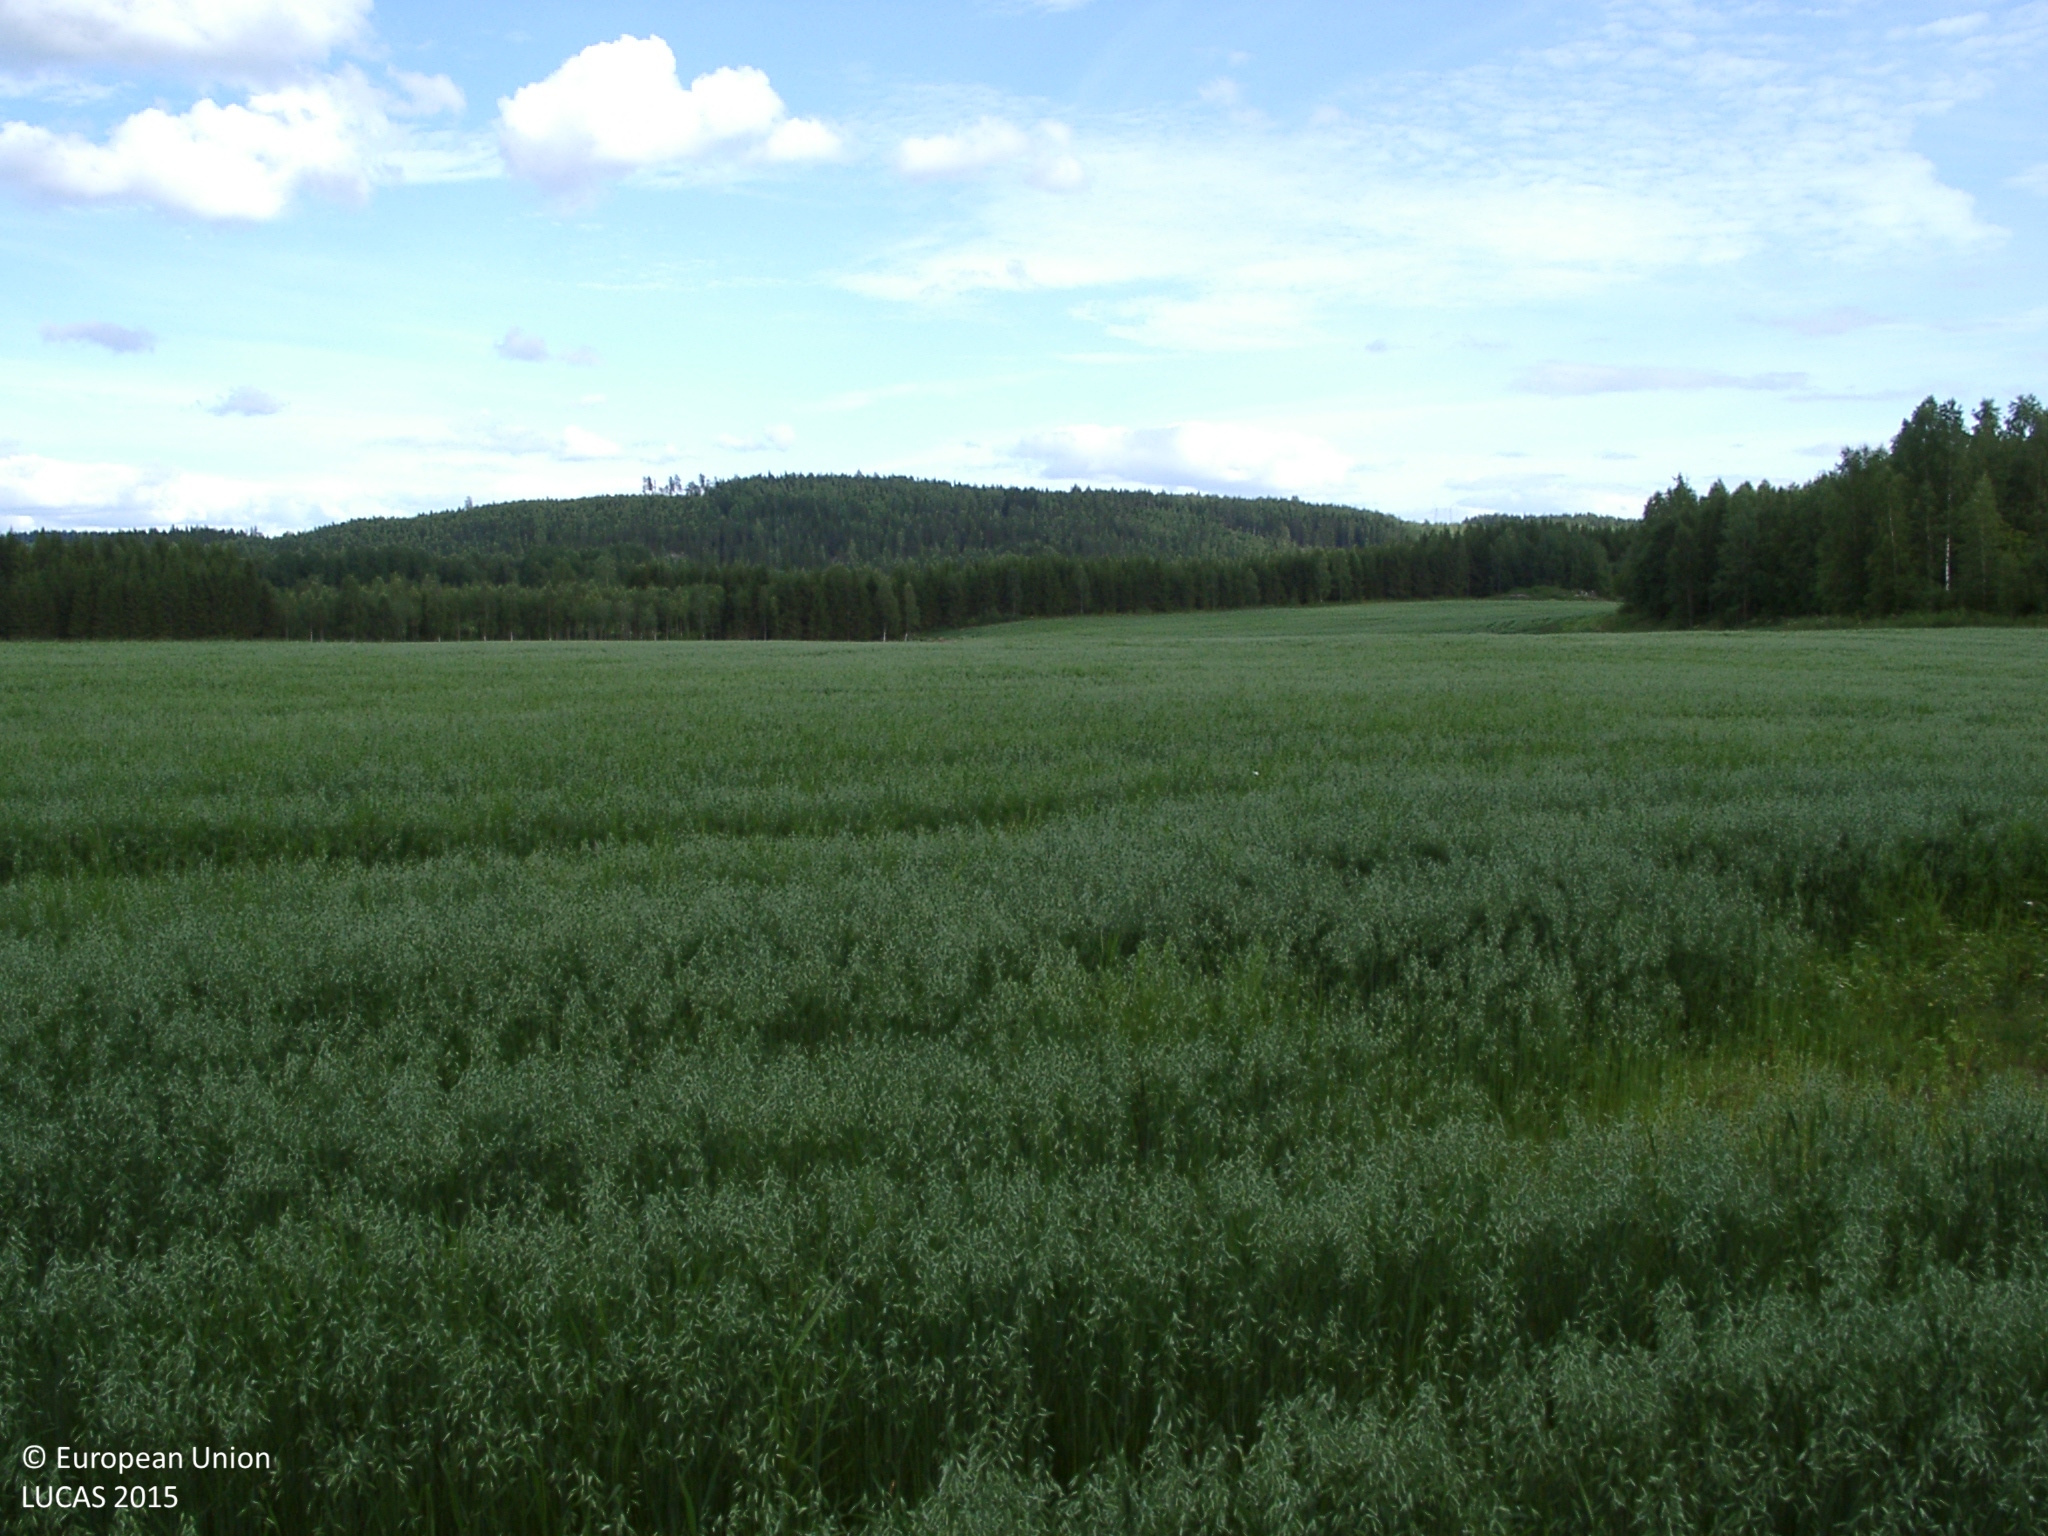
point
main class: Cropland
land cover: Oats
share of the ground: > 75 %
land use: Agriculture (excluding fallow land and kitchen gardens)
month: July
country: FI
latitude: 62.3657
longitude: 25.7538
